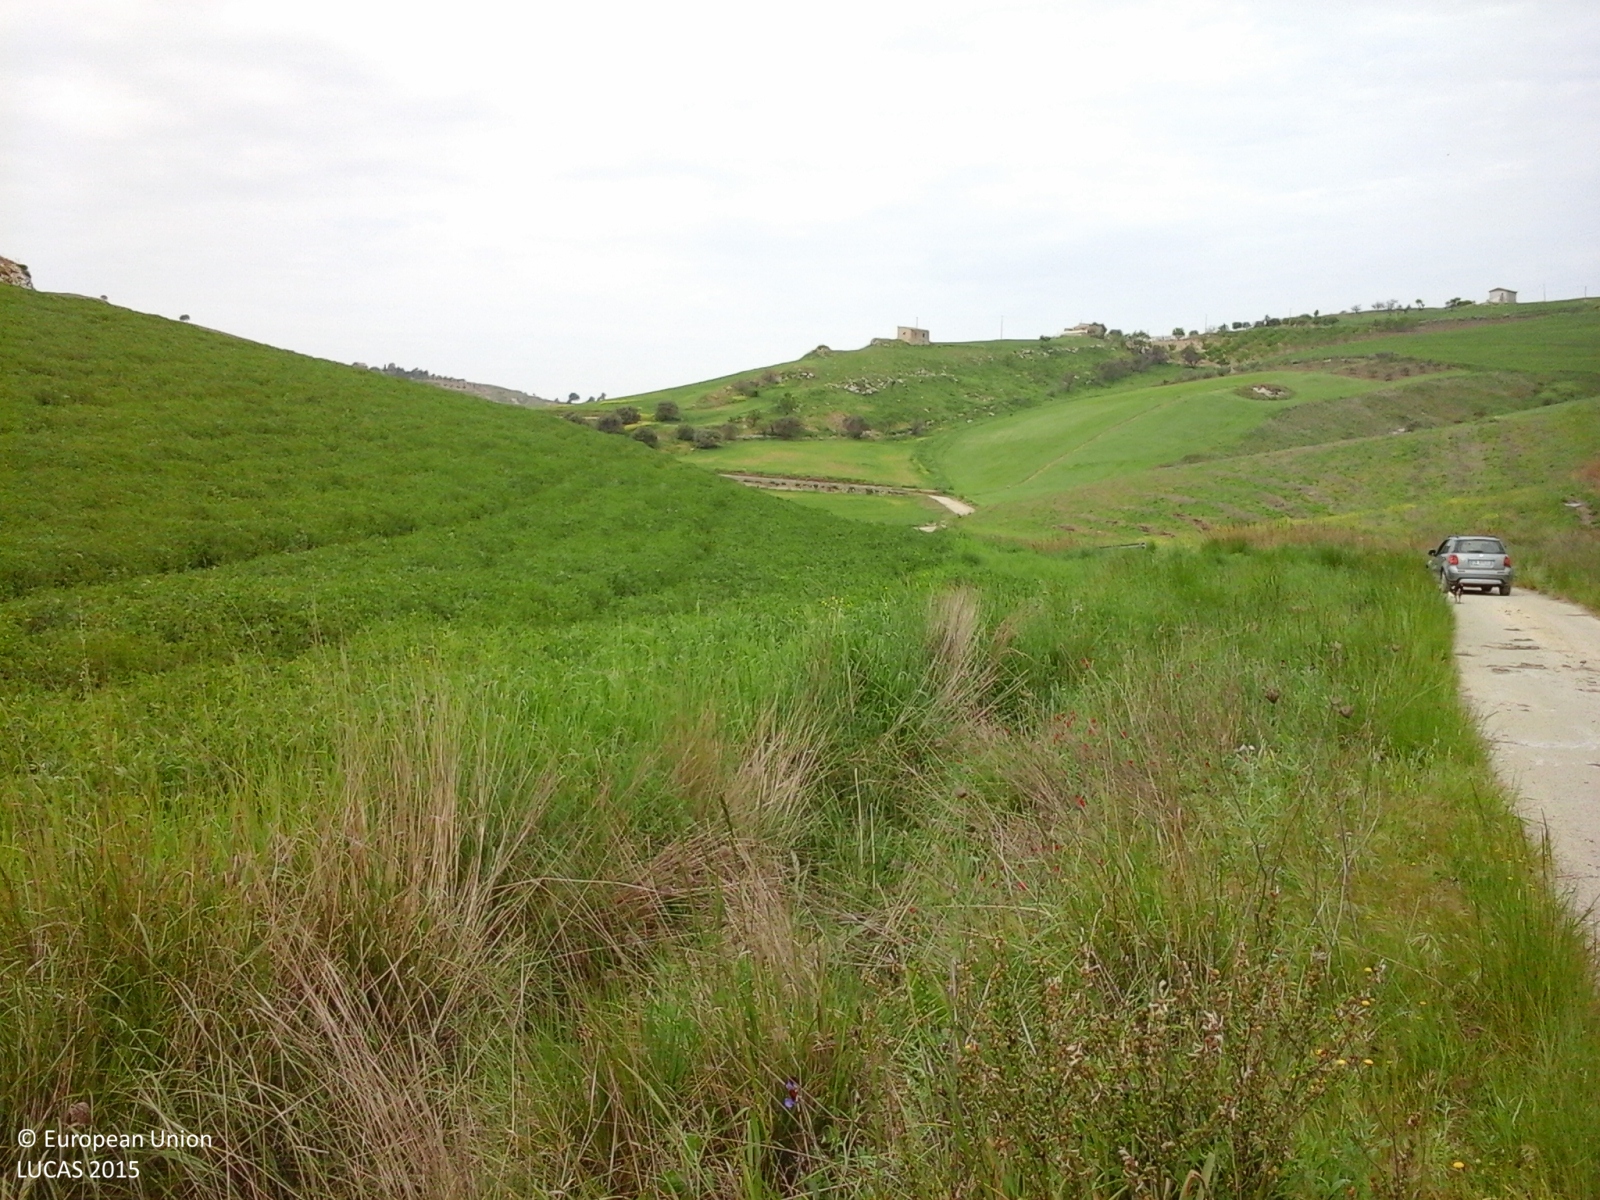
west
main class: Cropland
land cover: Dry pulses
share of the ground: > 75 %
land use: Agriculture (excluding fallow land and kitchen gardens)
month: April
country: IT
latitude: 37.4379
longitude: 13.7351
